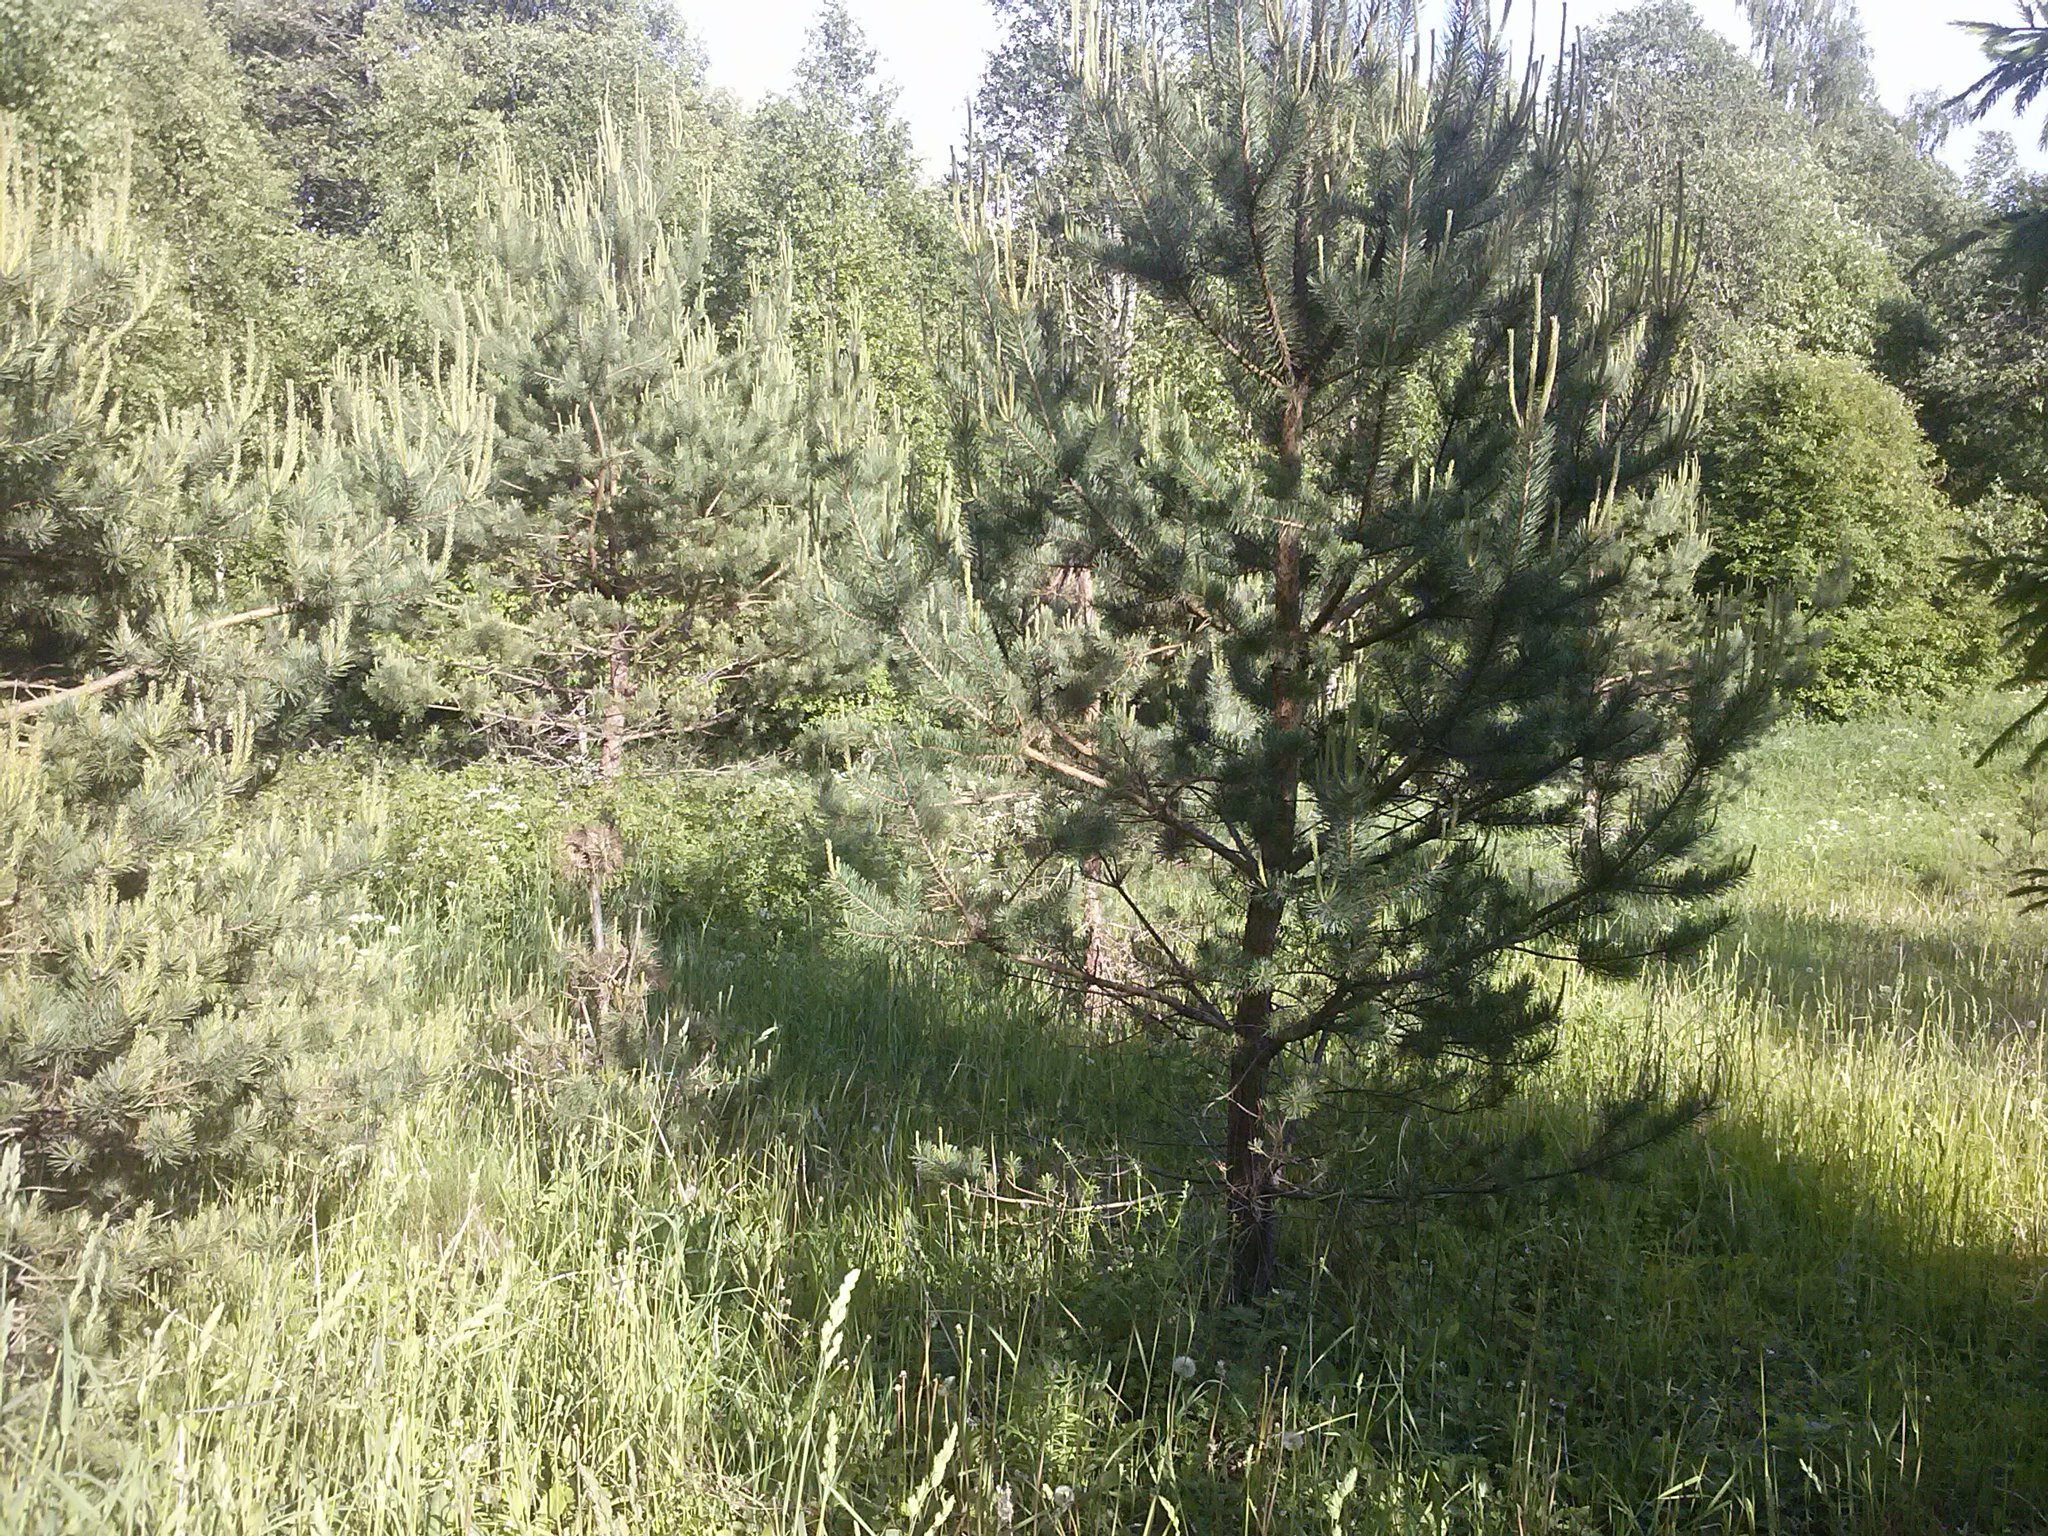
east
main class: Grassland
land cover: Grassland with sparse tree/shrub cover
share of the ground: > 75 %
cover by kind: herbaceous plants 90 %, coniferous forest trees 5 %, shrubs 5 %
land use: Forestry
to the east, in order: Grassland with sparse tree/shrub cover; Broadleaved woodland; Rivers and streams; Broadleaved woodland; Grassland with sparse tree/shrub cover; Grassland without tree/shrub cover; Grassland with sparse tree/shrub cover; Tracks; Broadleaved woodland; Grassland without tree/shrub cover
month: June
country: LV
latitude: 56.3530
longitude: 27.6461
